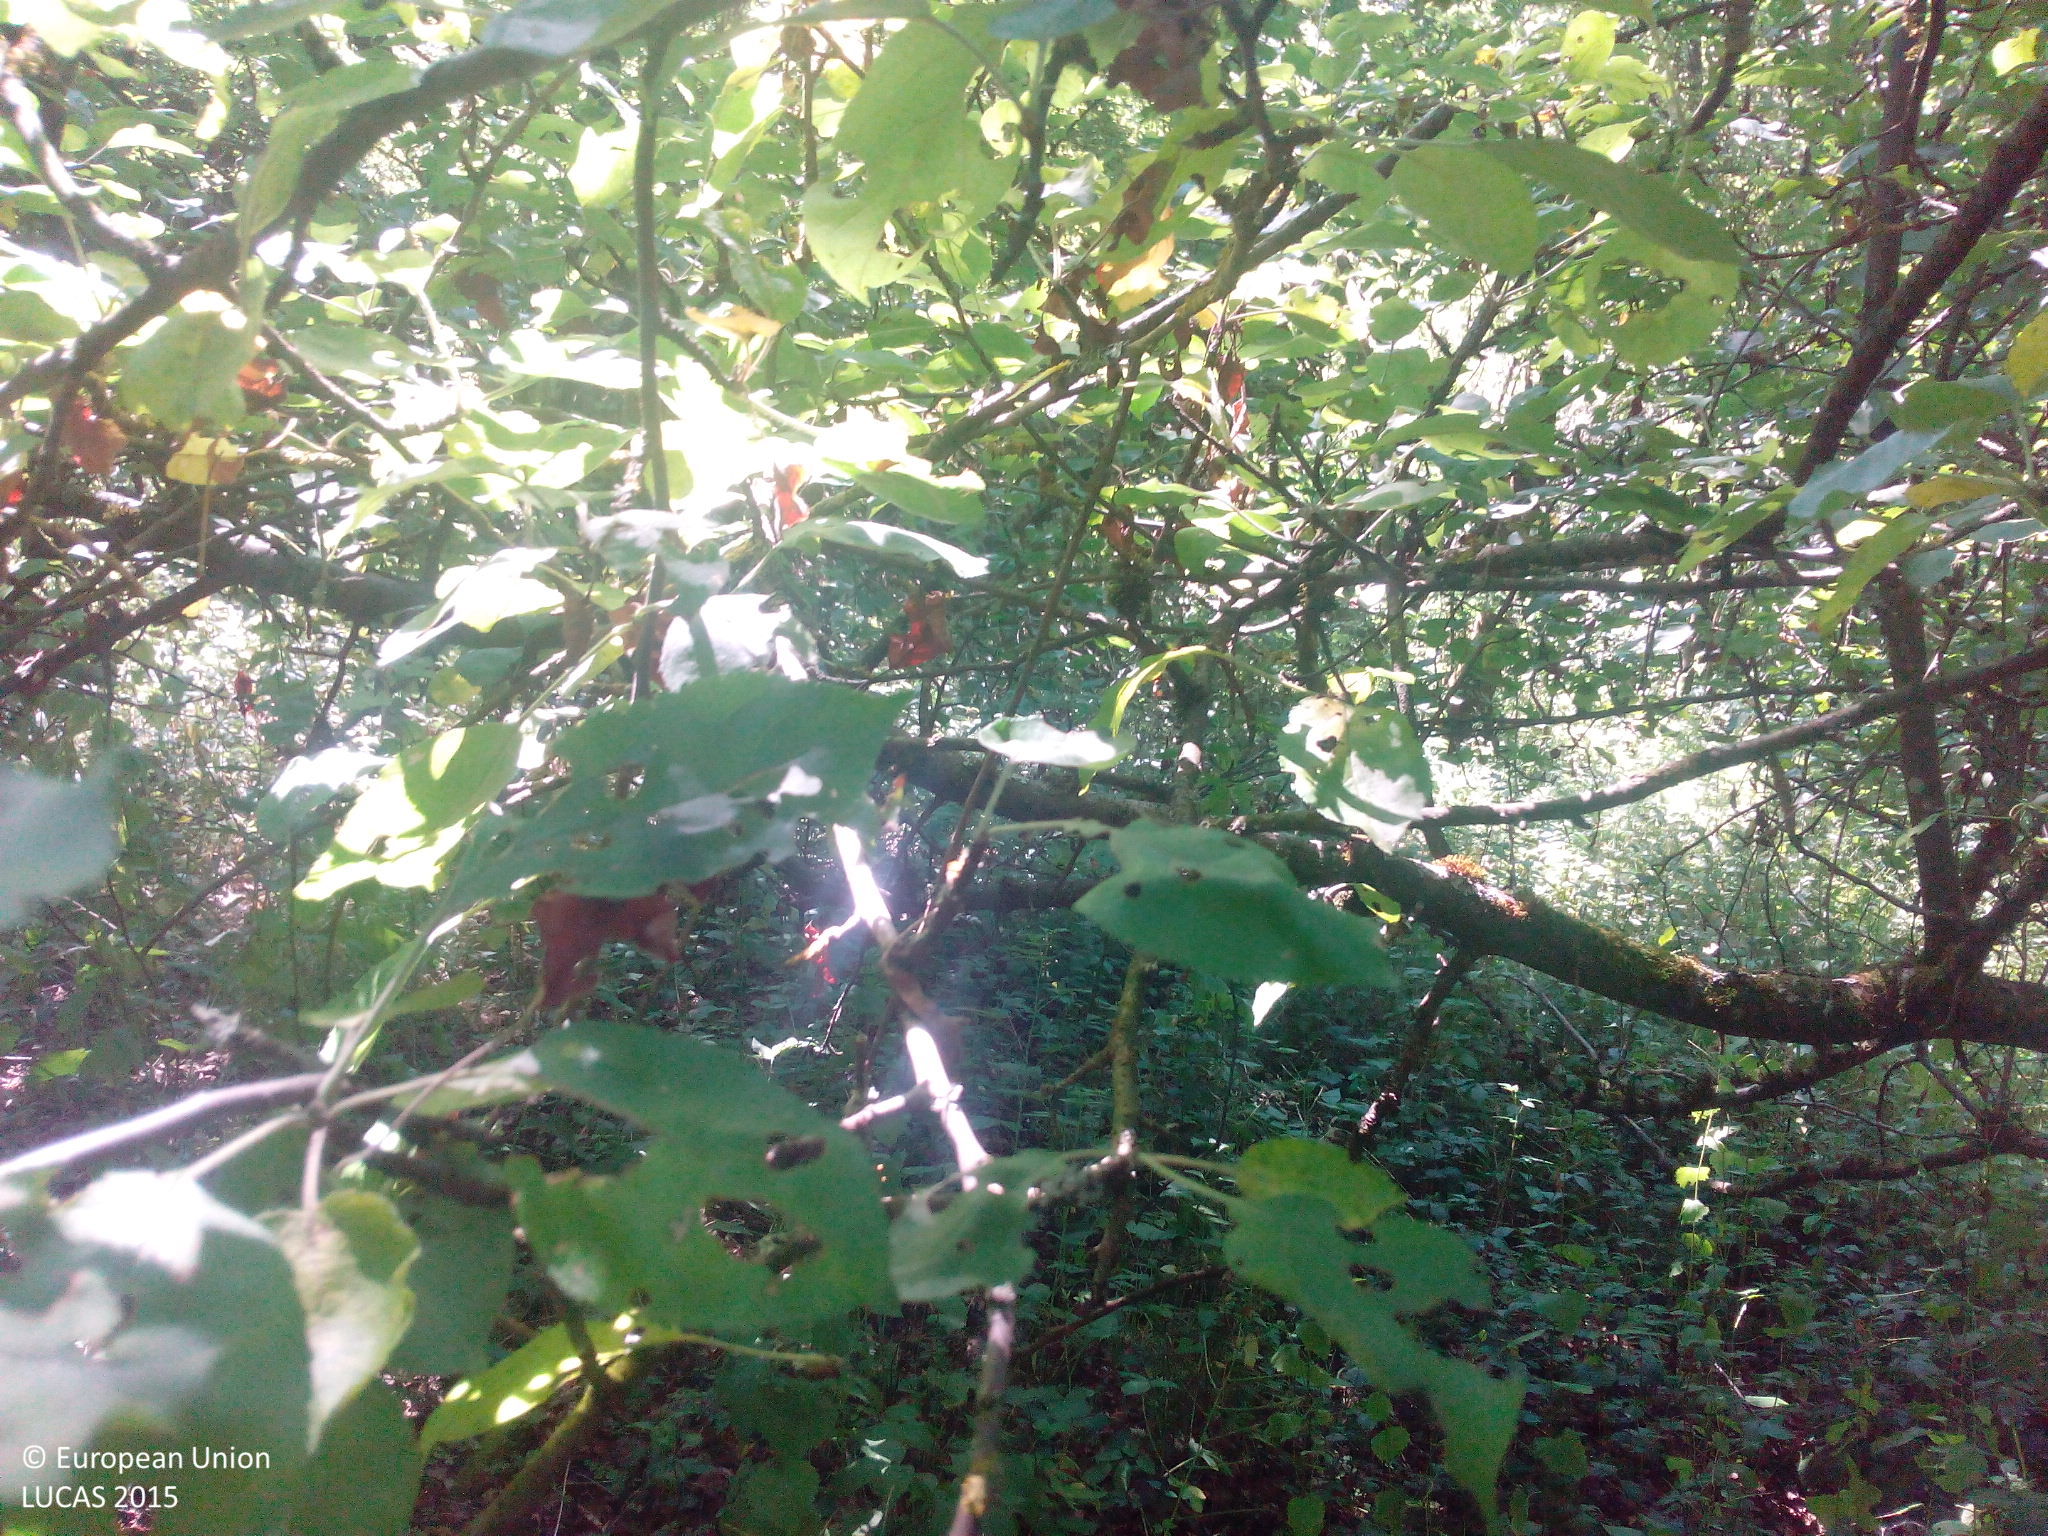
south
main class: Woodland
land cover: Broadleaved woodland
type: mesophytic deciduous forest
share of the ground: > 75 %
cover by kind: broadleaved forest trees 90 %, herbaceous plants 10 %
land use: Semi-natural and natural areas not in use
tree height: > 5 m
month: July
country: DE
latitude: 50.1285
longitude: 10.6293
